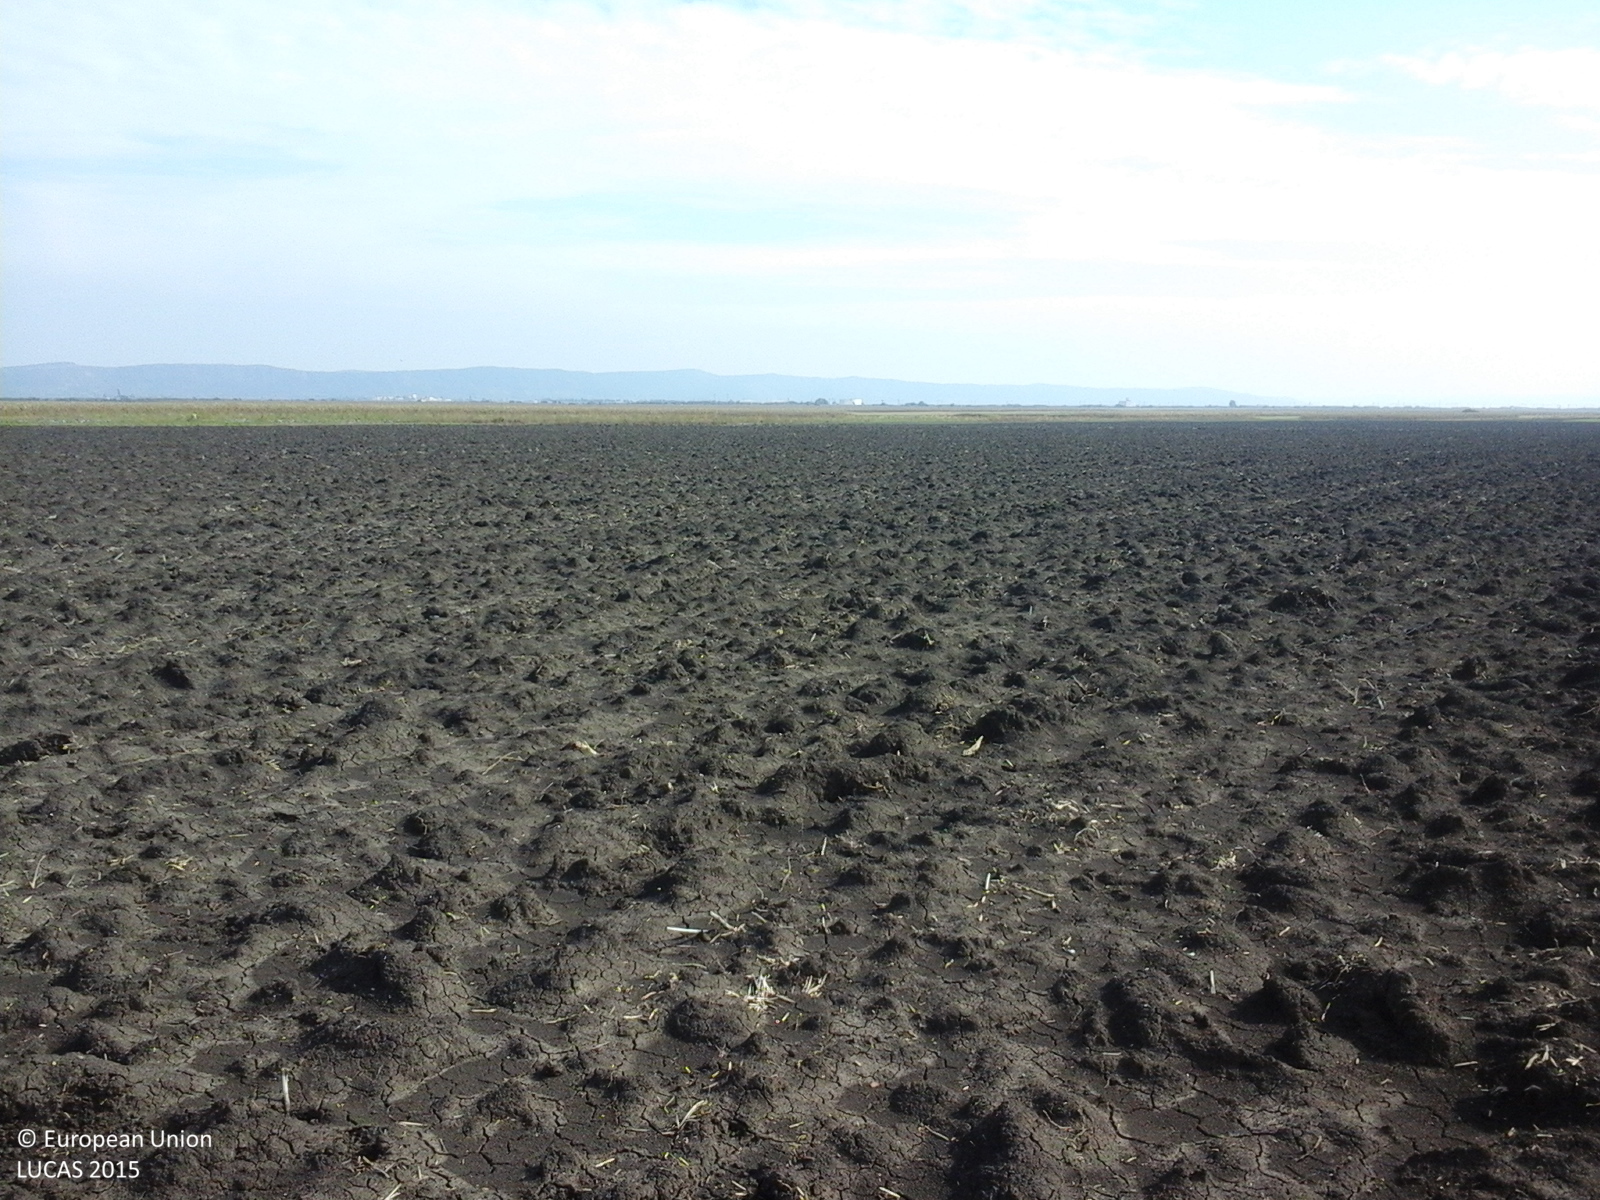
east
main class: Cropland
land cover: Rape and turnip rape
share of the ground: < 10 %
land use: Agriculture (excluding fallow land and kitchen gardens)
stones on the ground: < 10 %
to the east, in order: Rape and turnip rape; Tracks; Rape and turnip rape; Spontaneously vegetated surfaces
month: October
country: RO
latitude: 46.5044
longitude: 23.8481
